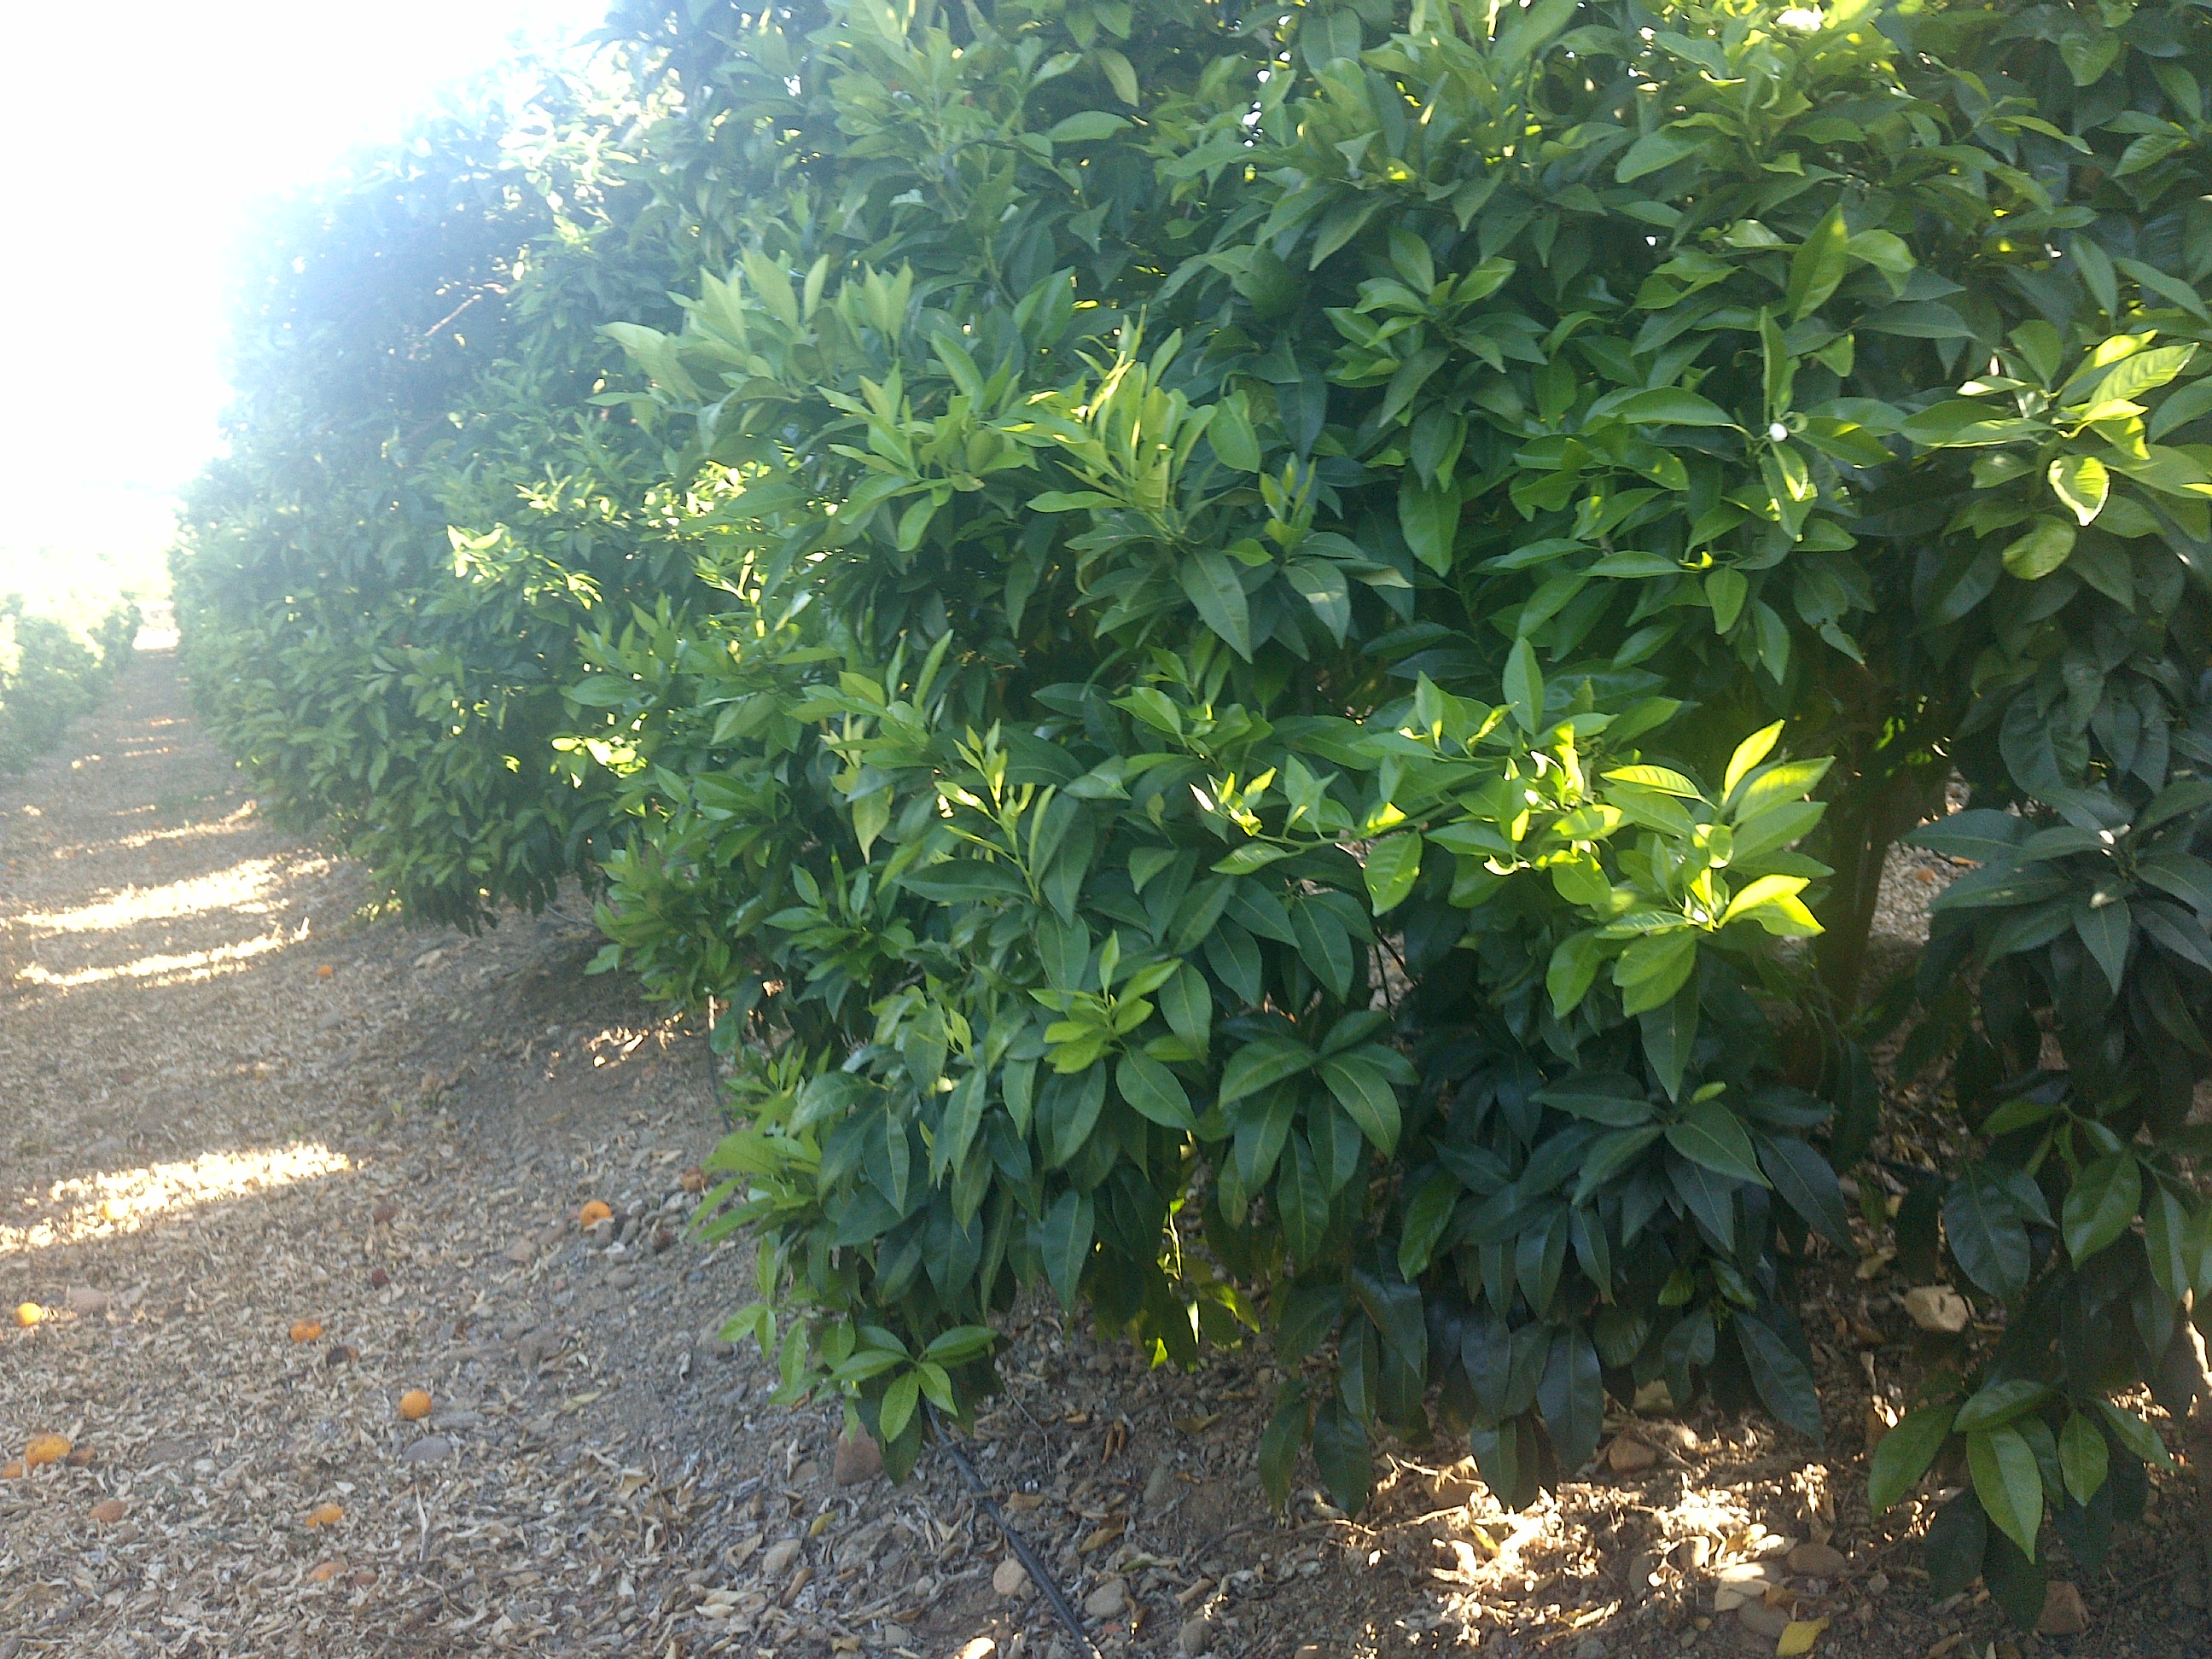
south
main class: Cropland
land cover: Oranges
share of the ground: > 75 %
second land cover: Other bare soil
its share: > 75 %
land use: Agriculture (excluding fallow land and kitchen gardens)
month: May
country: ES
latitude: 37.8021
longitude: -5.2270
